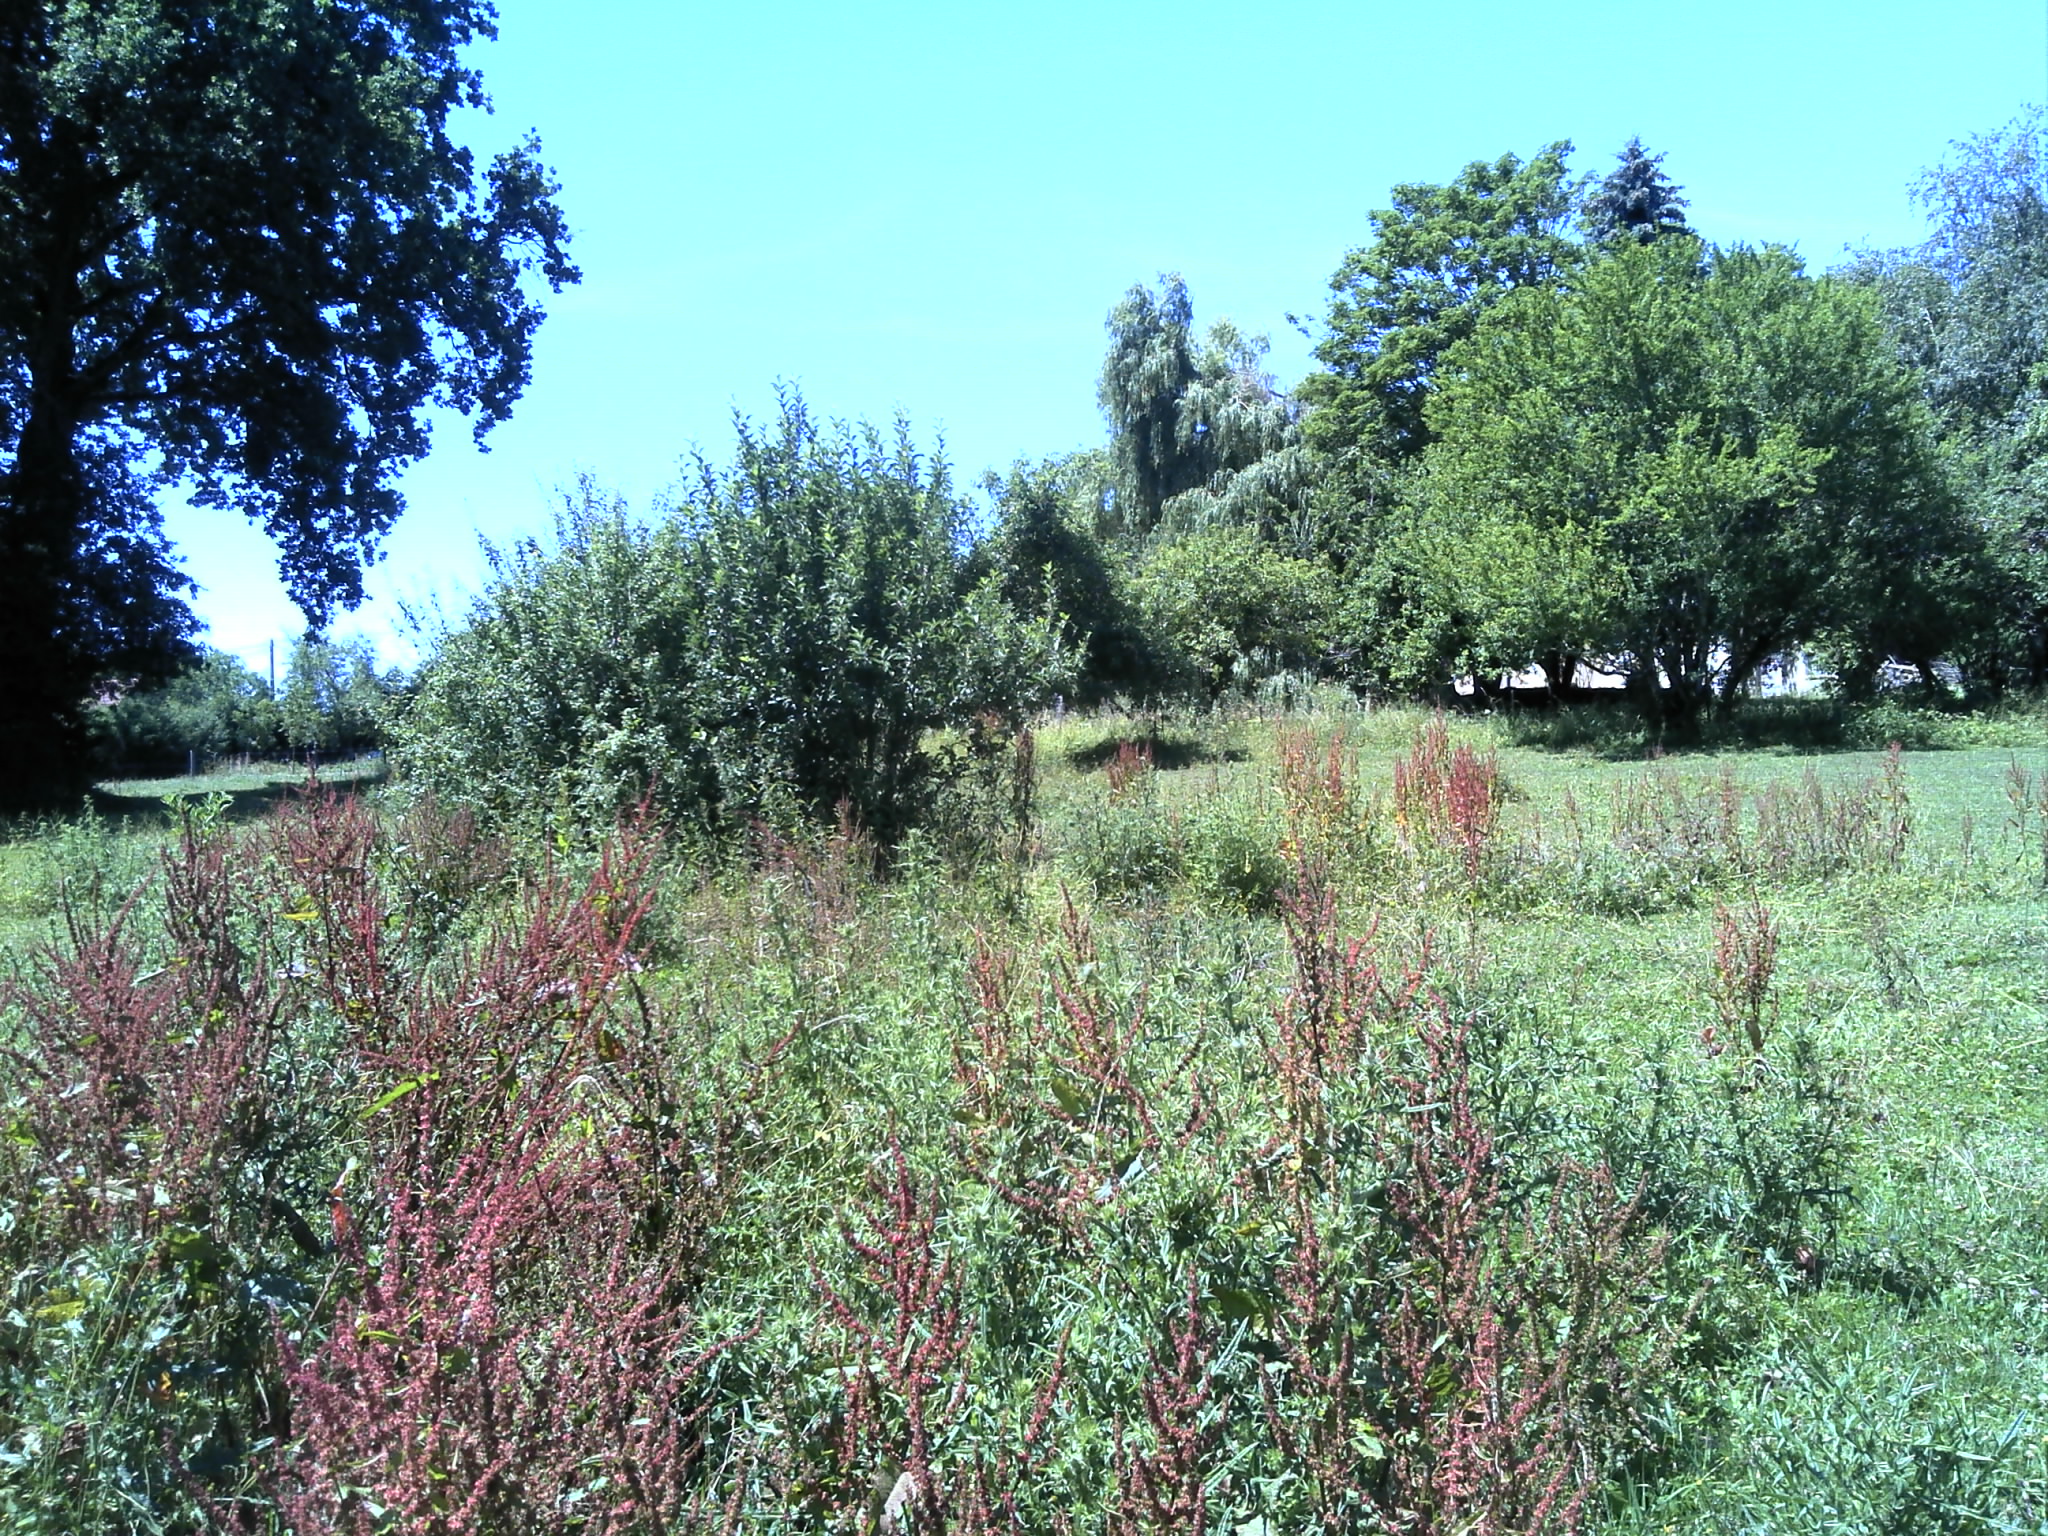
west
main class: Grassland
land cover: Grassland with sparse tree/shrub cover
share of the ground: > 75 %
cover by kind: herbaceous plants 90 %, broadleaved forest trees 5 %, shrubs 5 %
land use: Agriculture (excluding fallow land and kitchen gardens)
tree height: > 5 m
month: June
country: FR
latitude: 46.4995
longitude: 2.1885
